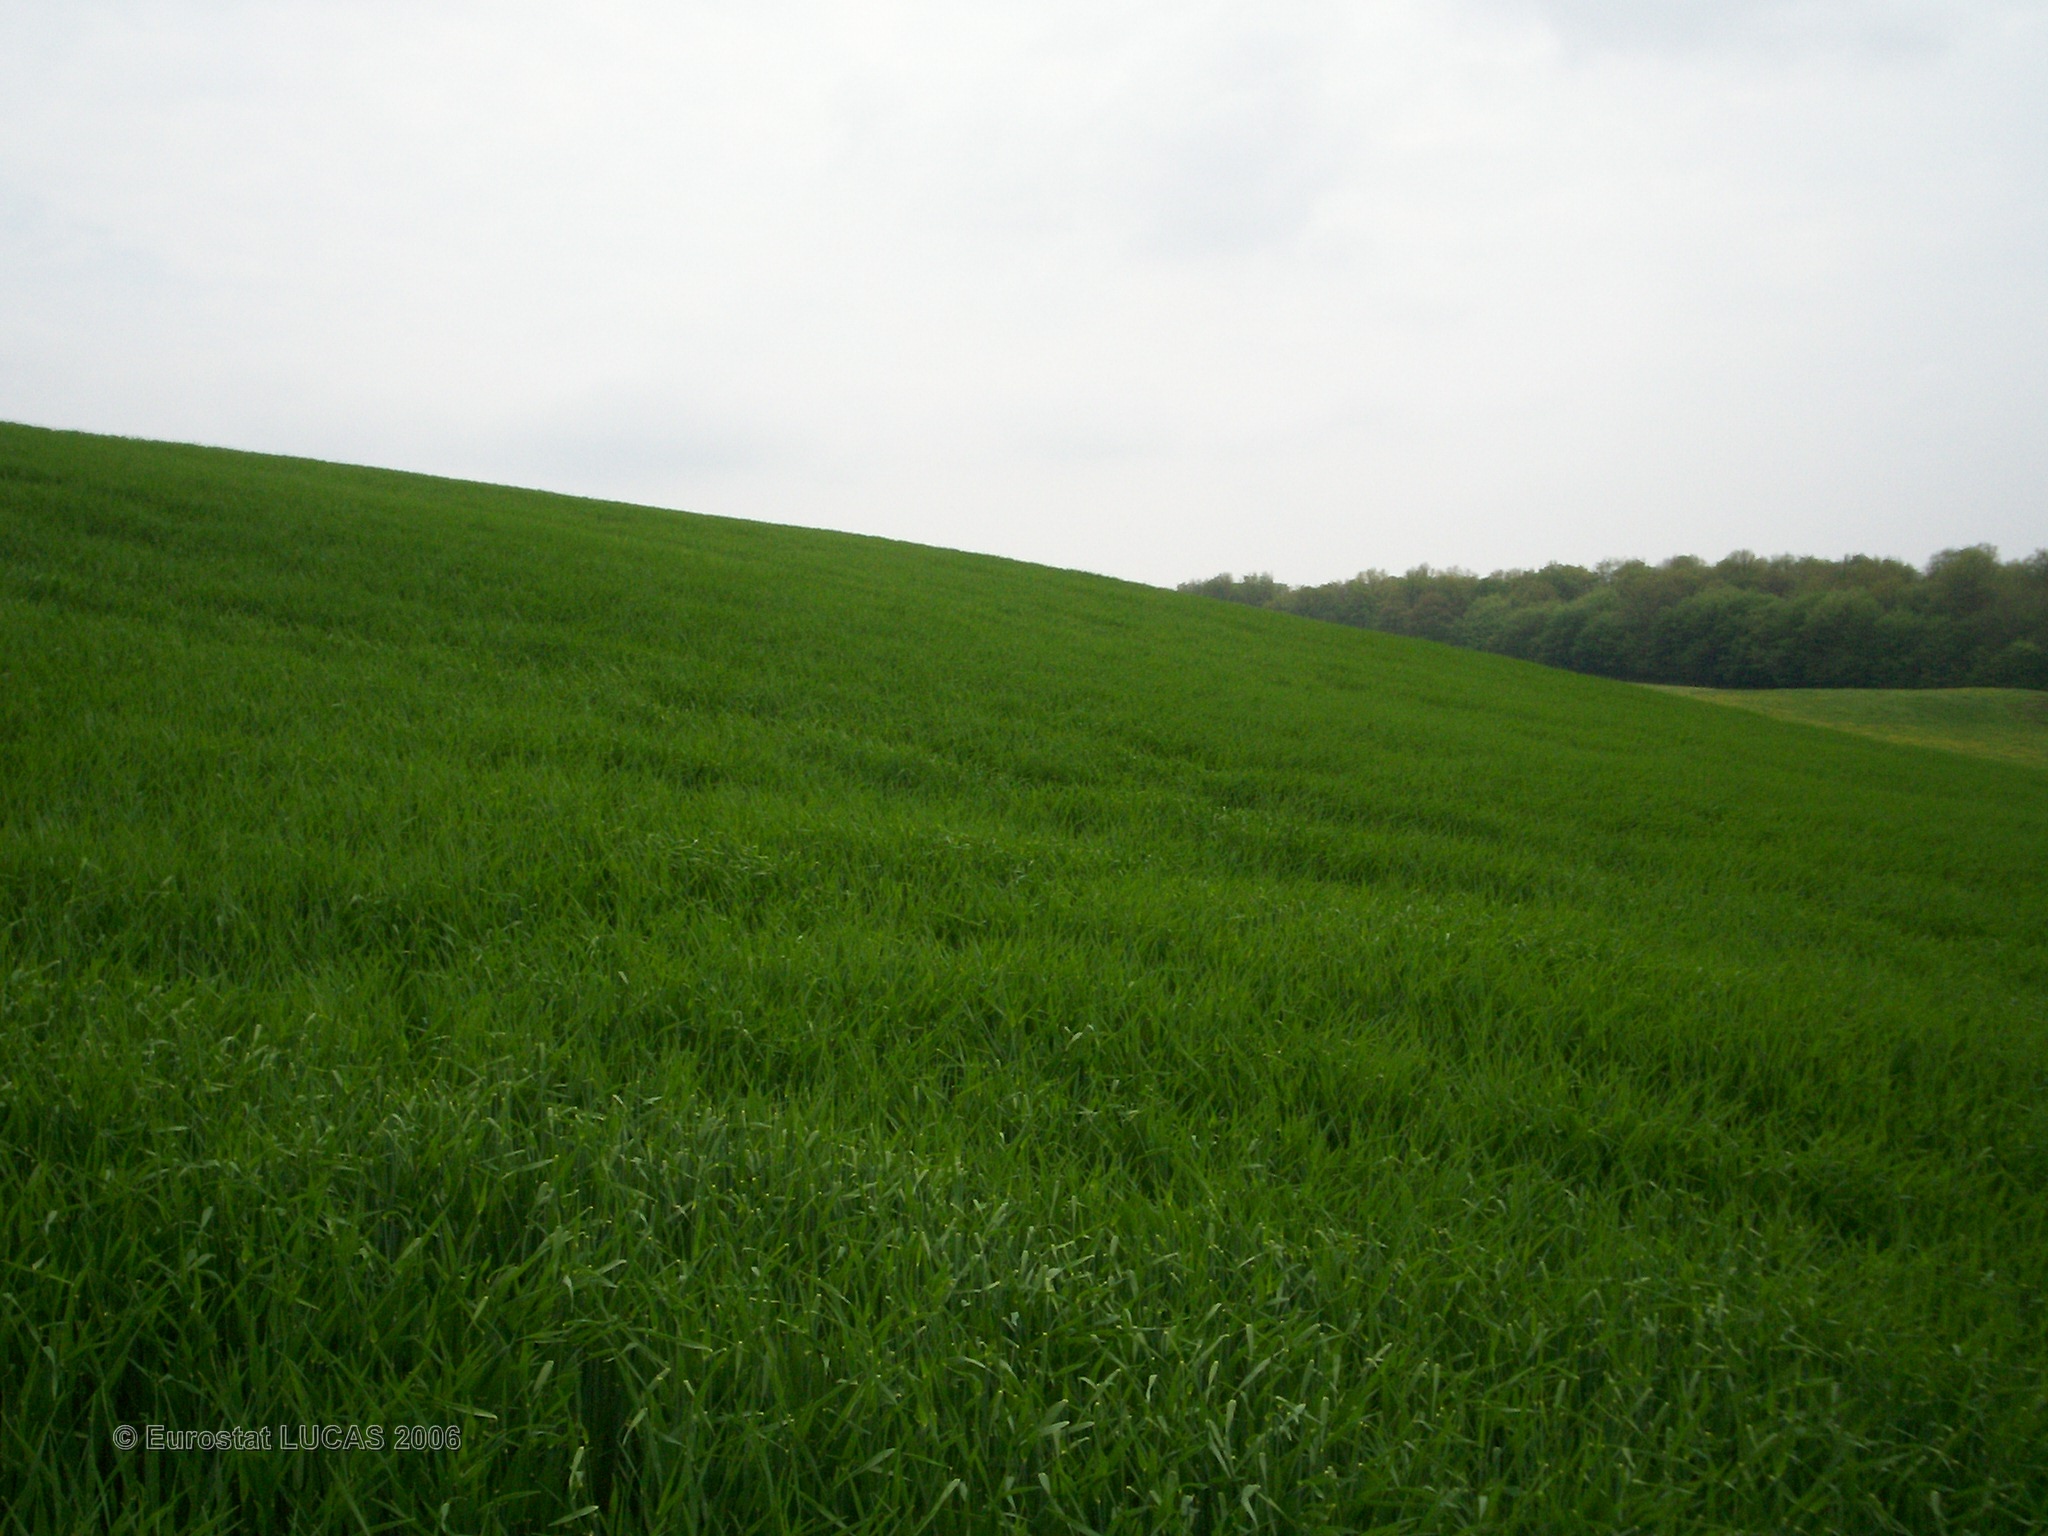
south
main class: Cropland
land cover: Barley
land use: Agriculture (excluding fallow land and kitchen gardens)
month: May
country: FR
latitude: 47.4401
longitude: 3.8847
